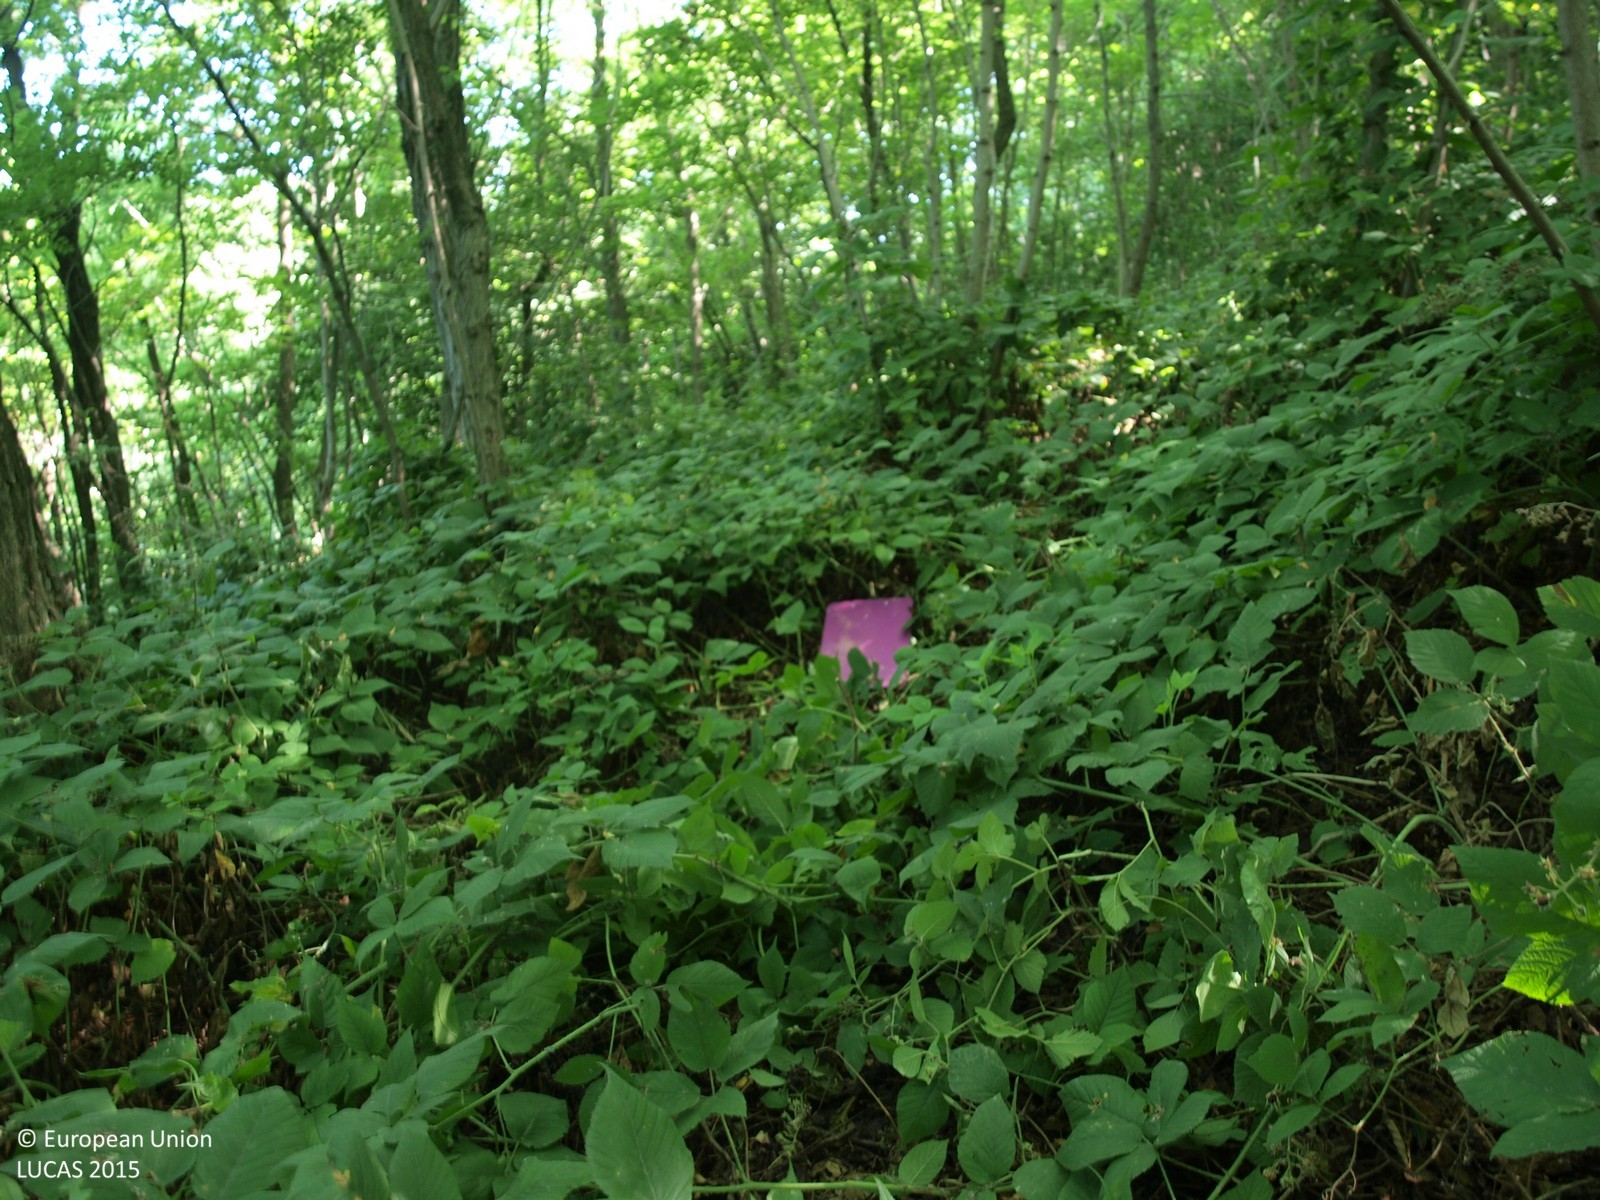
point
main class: Woodland
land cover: Broadleaved woodland
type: mesophytic deciduous forest
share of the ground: > 75 %
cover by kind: broadleaved forest trees 100 %
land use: Forestry
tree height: > 5 m
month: July
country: HR
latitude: 45.8905
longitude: 15.7323
